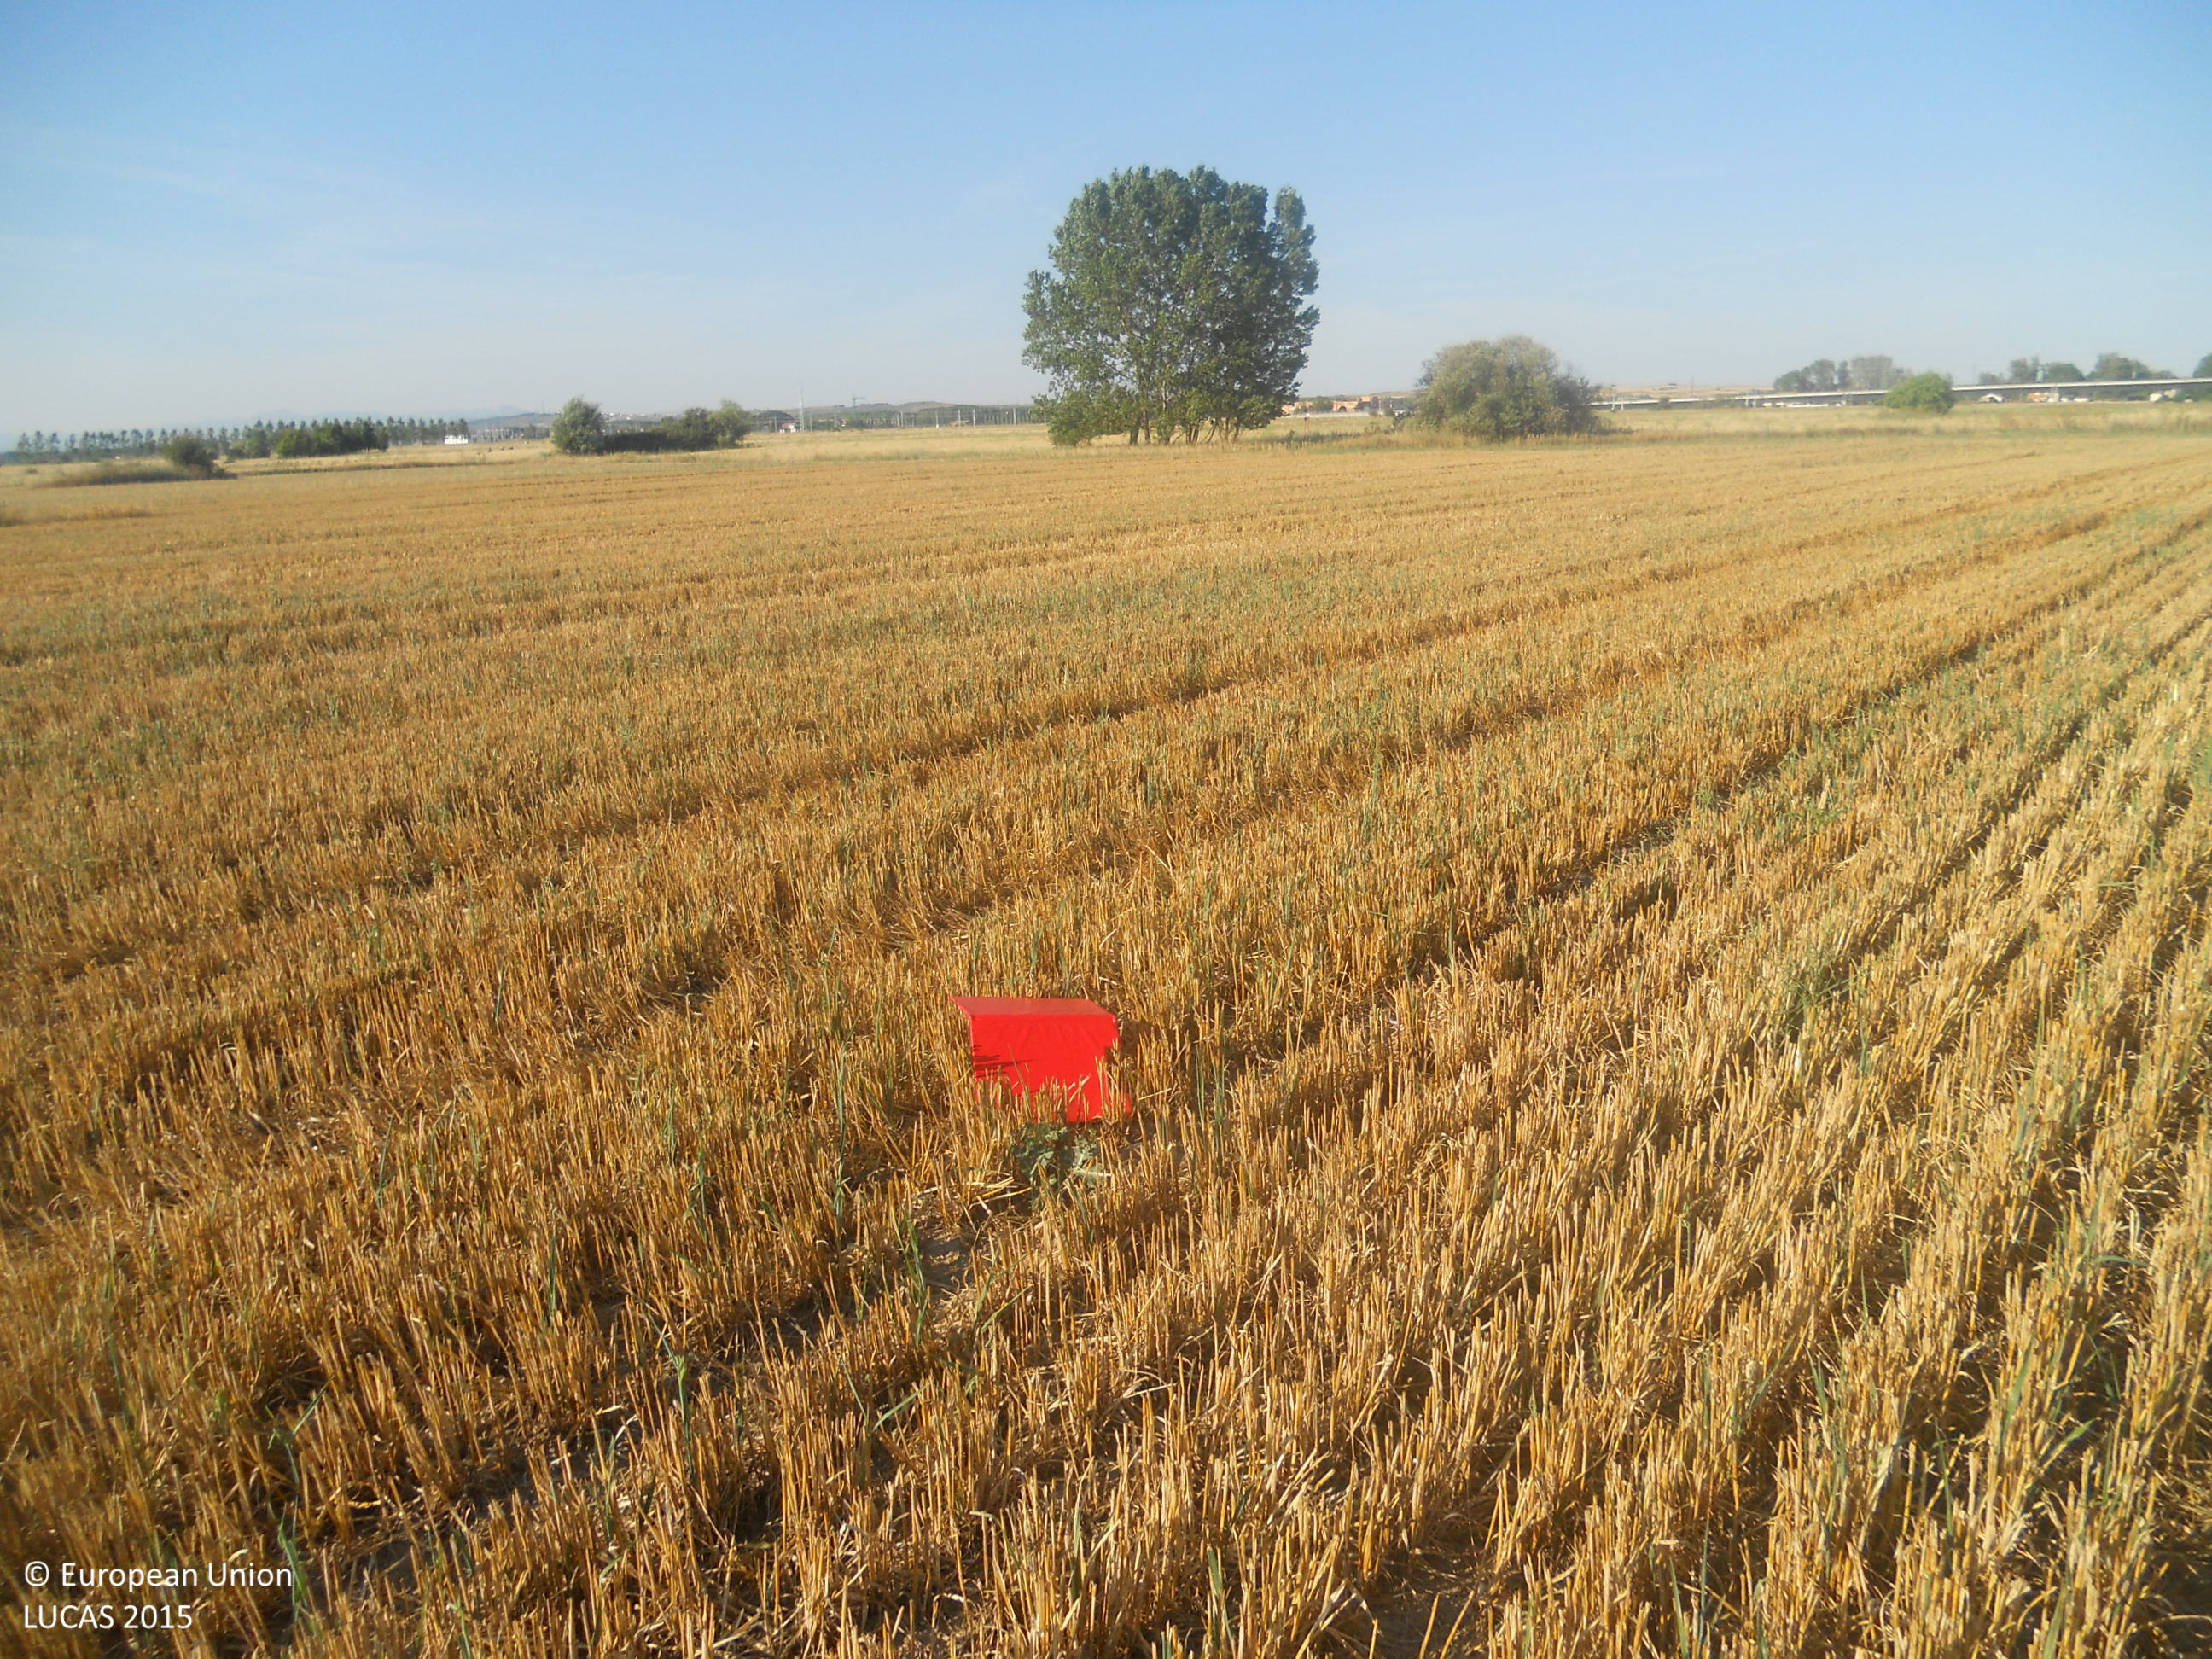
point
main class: Cropland
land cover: Oats
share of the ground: > 75 %
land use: Agriculture (excluding fallow land and kitchen gardens)
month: July
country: ES
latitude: 42.5070
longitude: -5.5638
